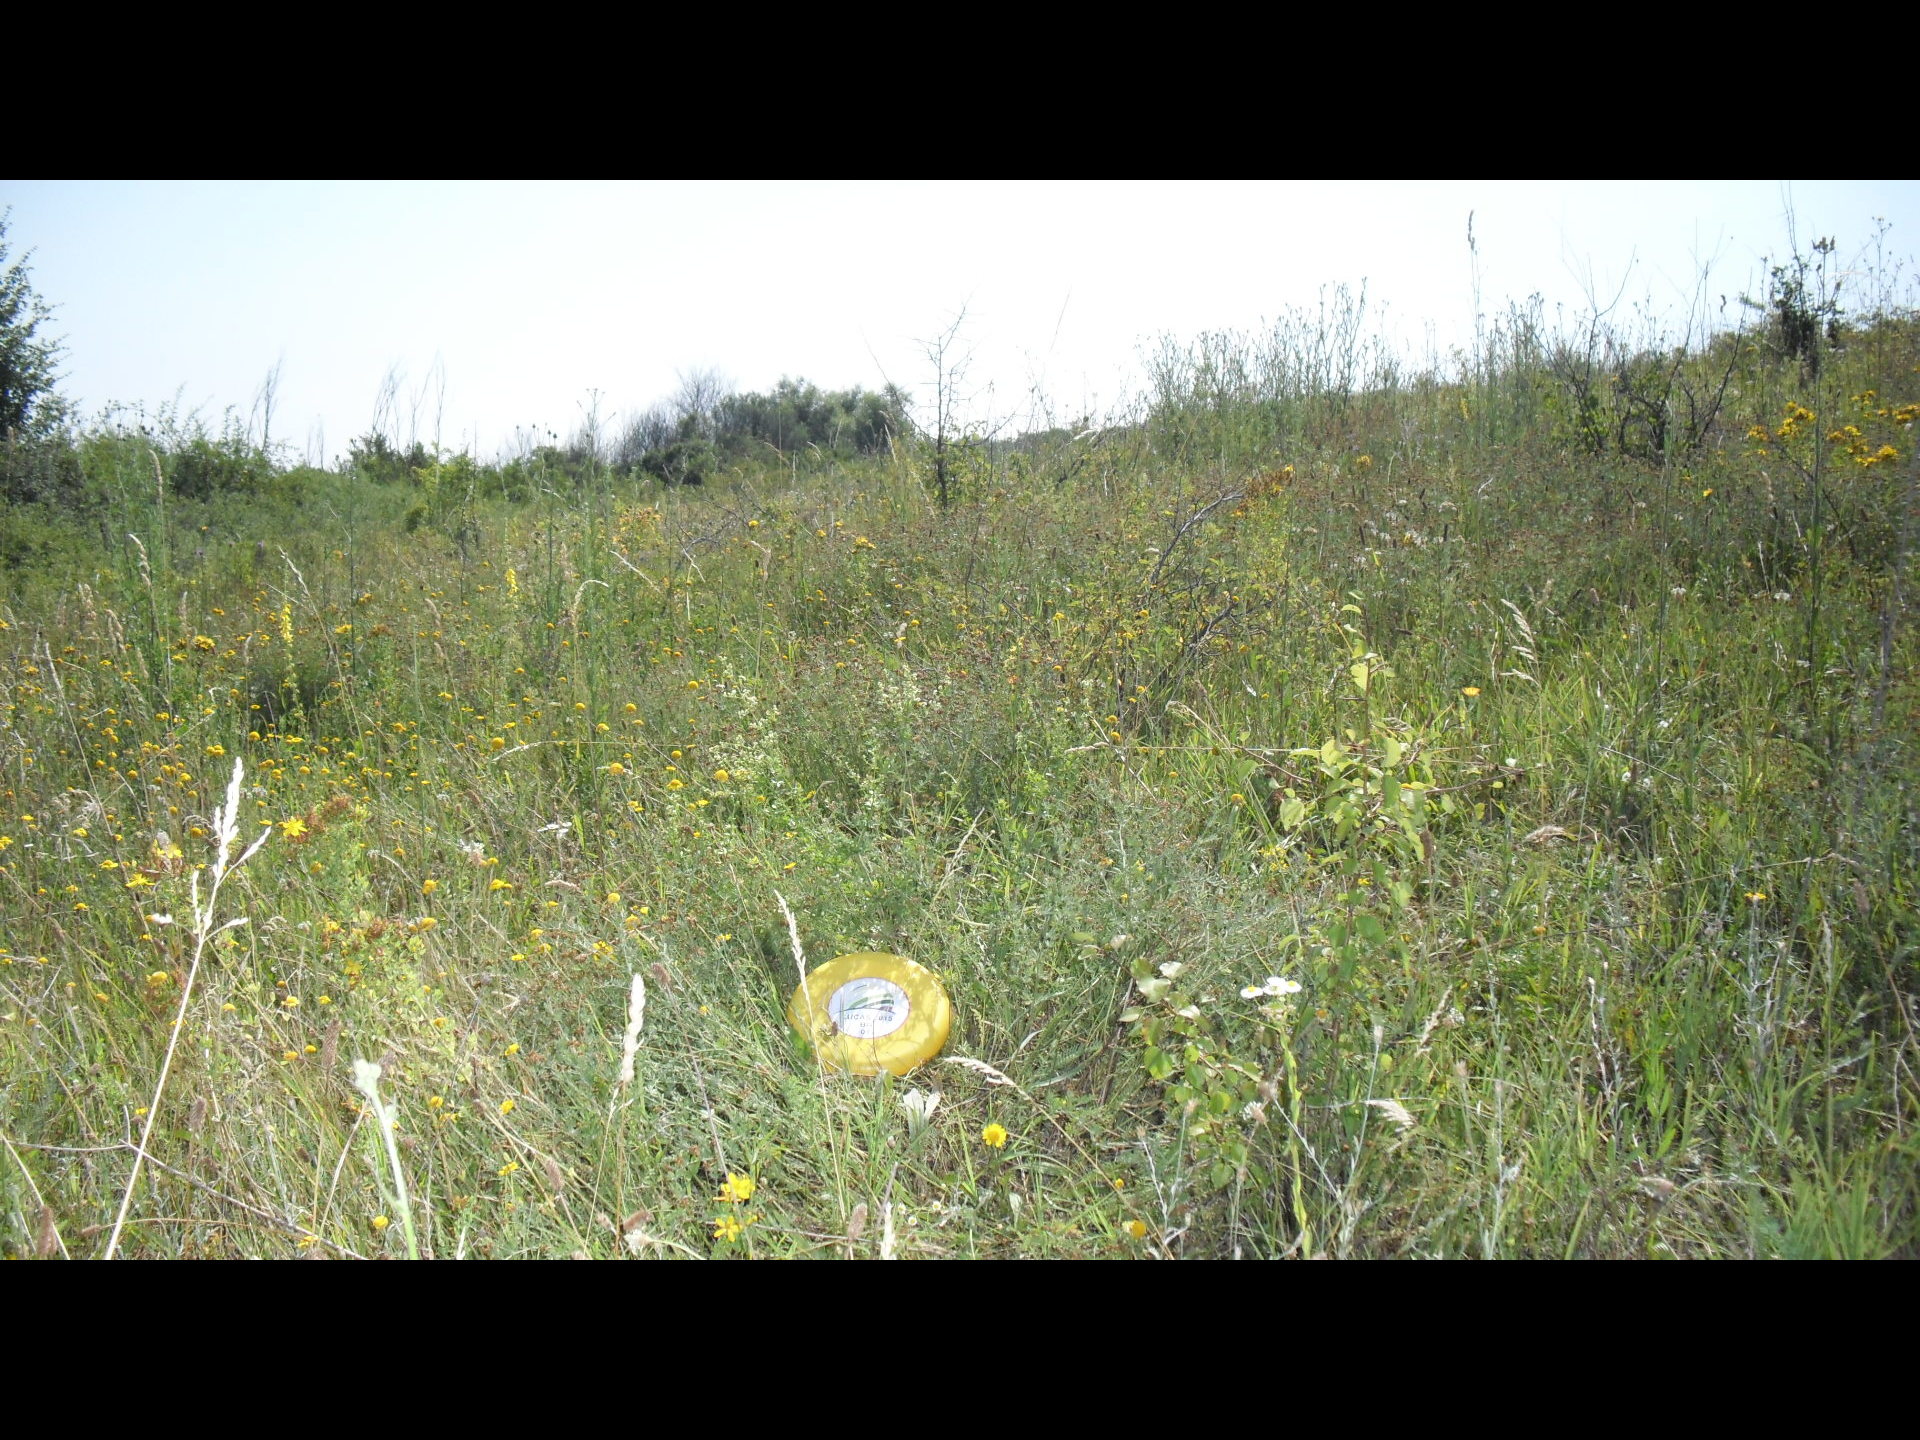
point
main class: Grassland
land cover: Grassland with sparse tree/shrub cover
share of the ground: > 75 %
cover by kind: herbaceous plants 90 %, broadleaved forest trees 5 %, shrubs 5 %
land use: Semi-natural and natural areas not in use
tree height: < 5 m
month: July
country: BG
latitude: 43.8030
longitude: 22.8528
